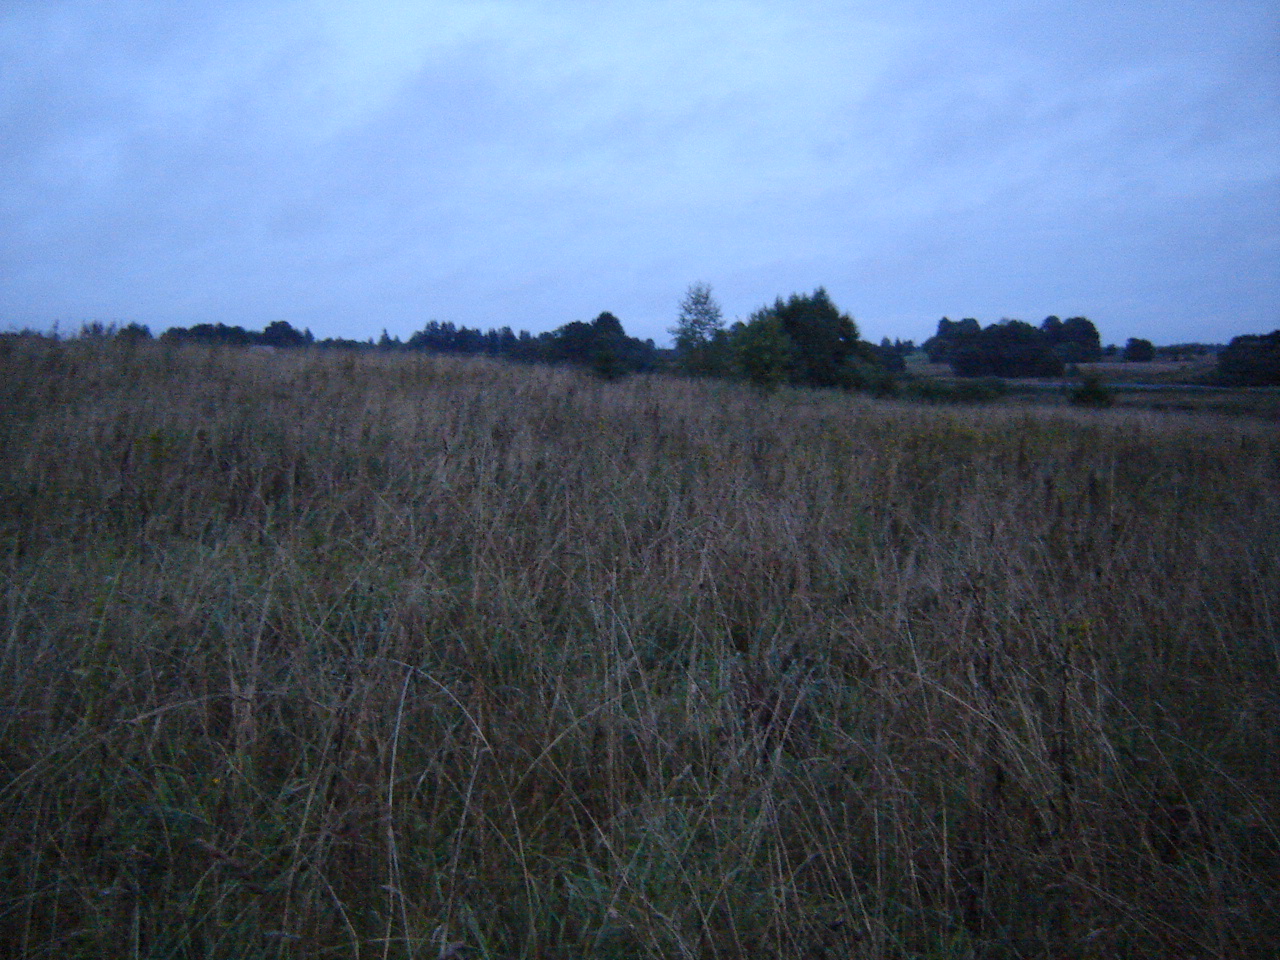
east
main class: Grassland
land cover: Spontaneously vegetated surfaces
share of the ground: > 75 %
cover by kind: herbaceous plants 100 %
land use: Fallow land
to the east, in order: Spontaneously vegetated surfaces; Grassland with sparse tree/shrub cover; Spontaneously vegetated surfaces
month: September
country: LT
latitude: 54.9276
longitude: 25.3368
